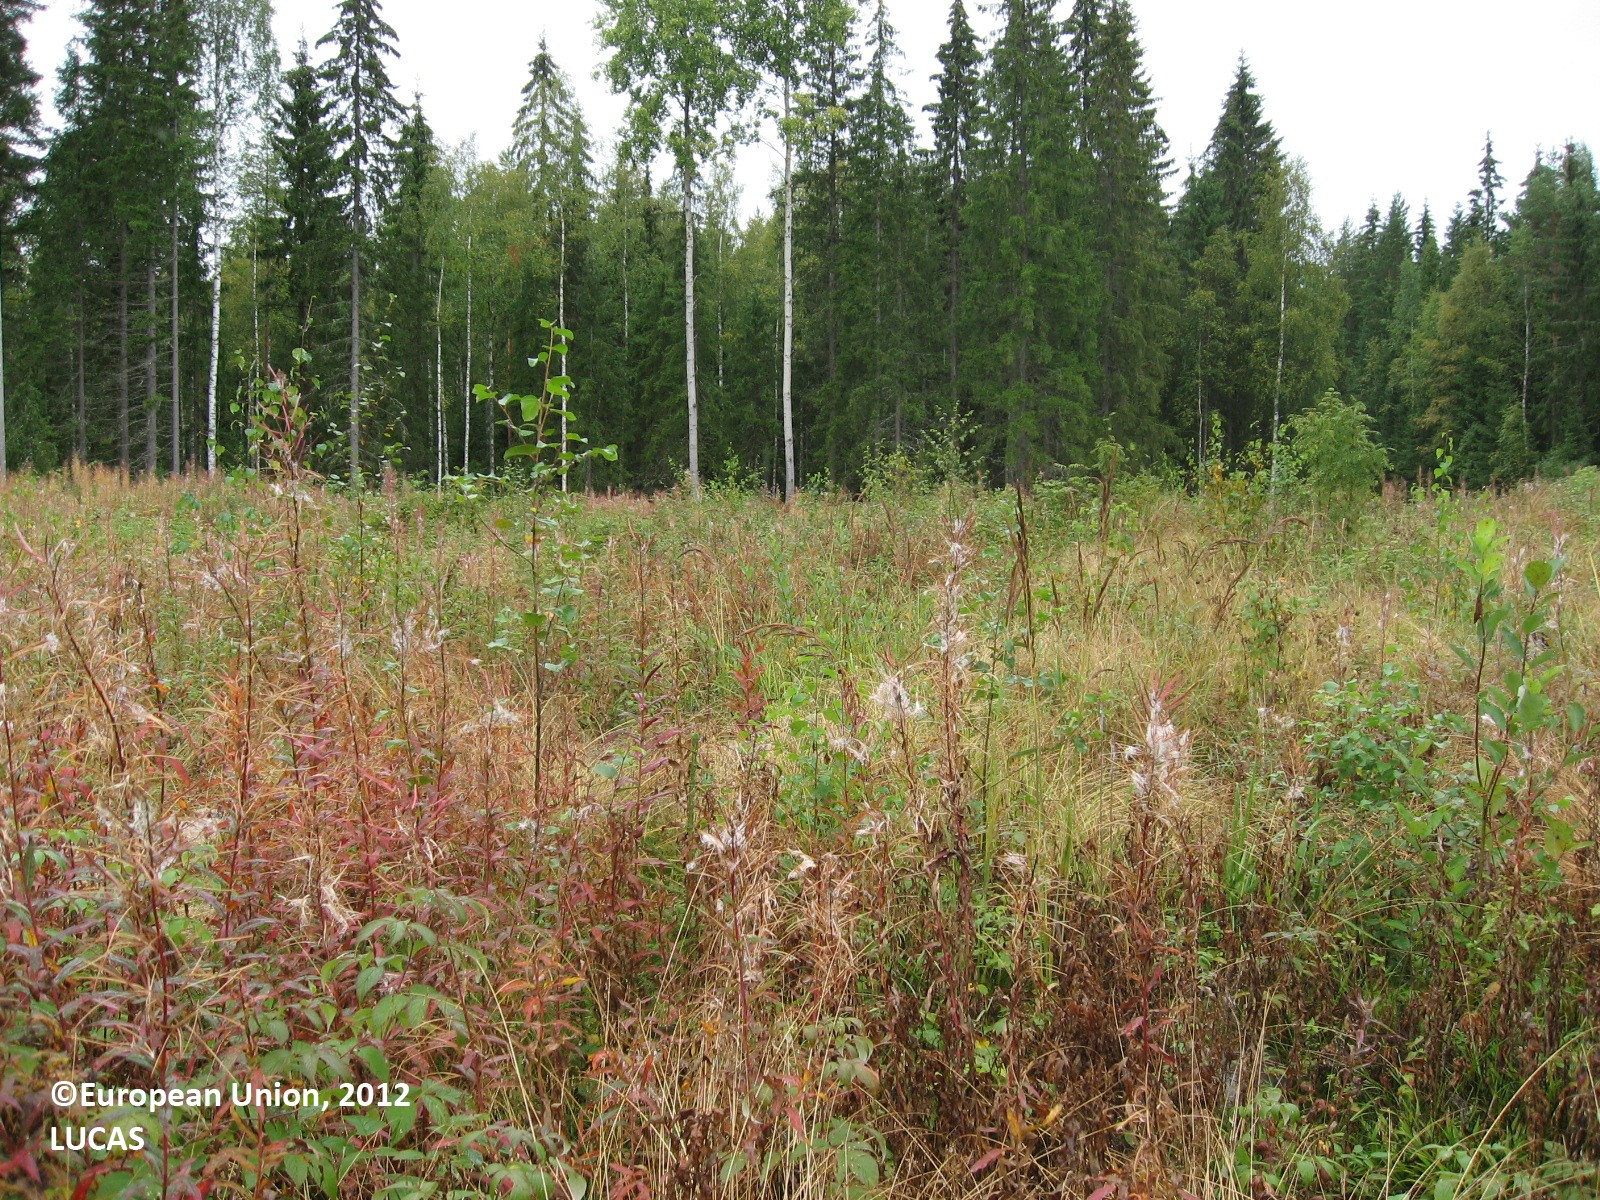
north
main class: Shrubland
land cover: Shrubland with sparse tree cover
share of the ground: > 75 %
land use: Forestry
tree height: < 5 m
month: August
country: FI
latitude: 61.4213
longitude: 24.7398
